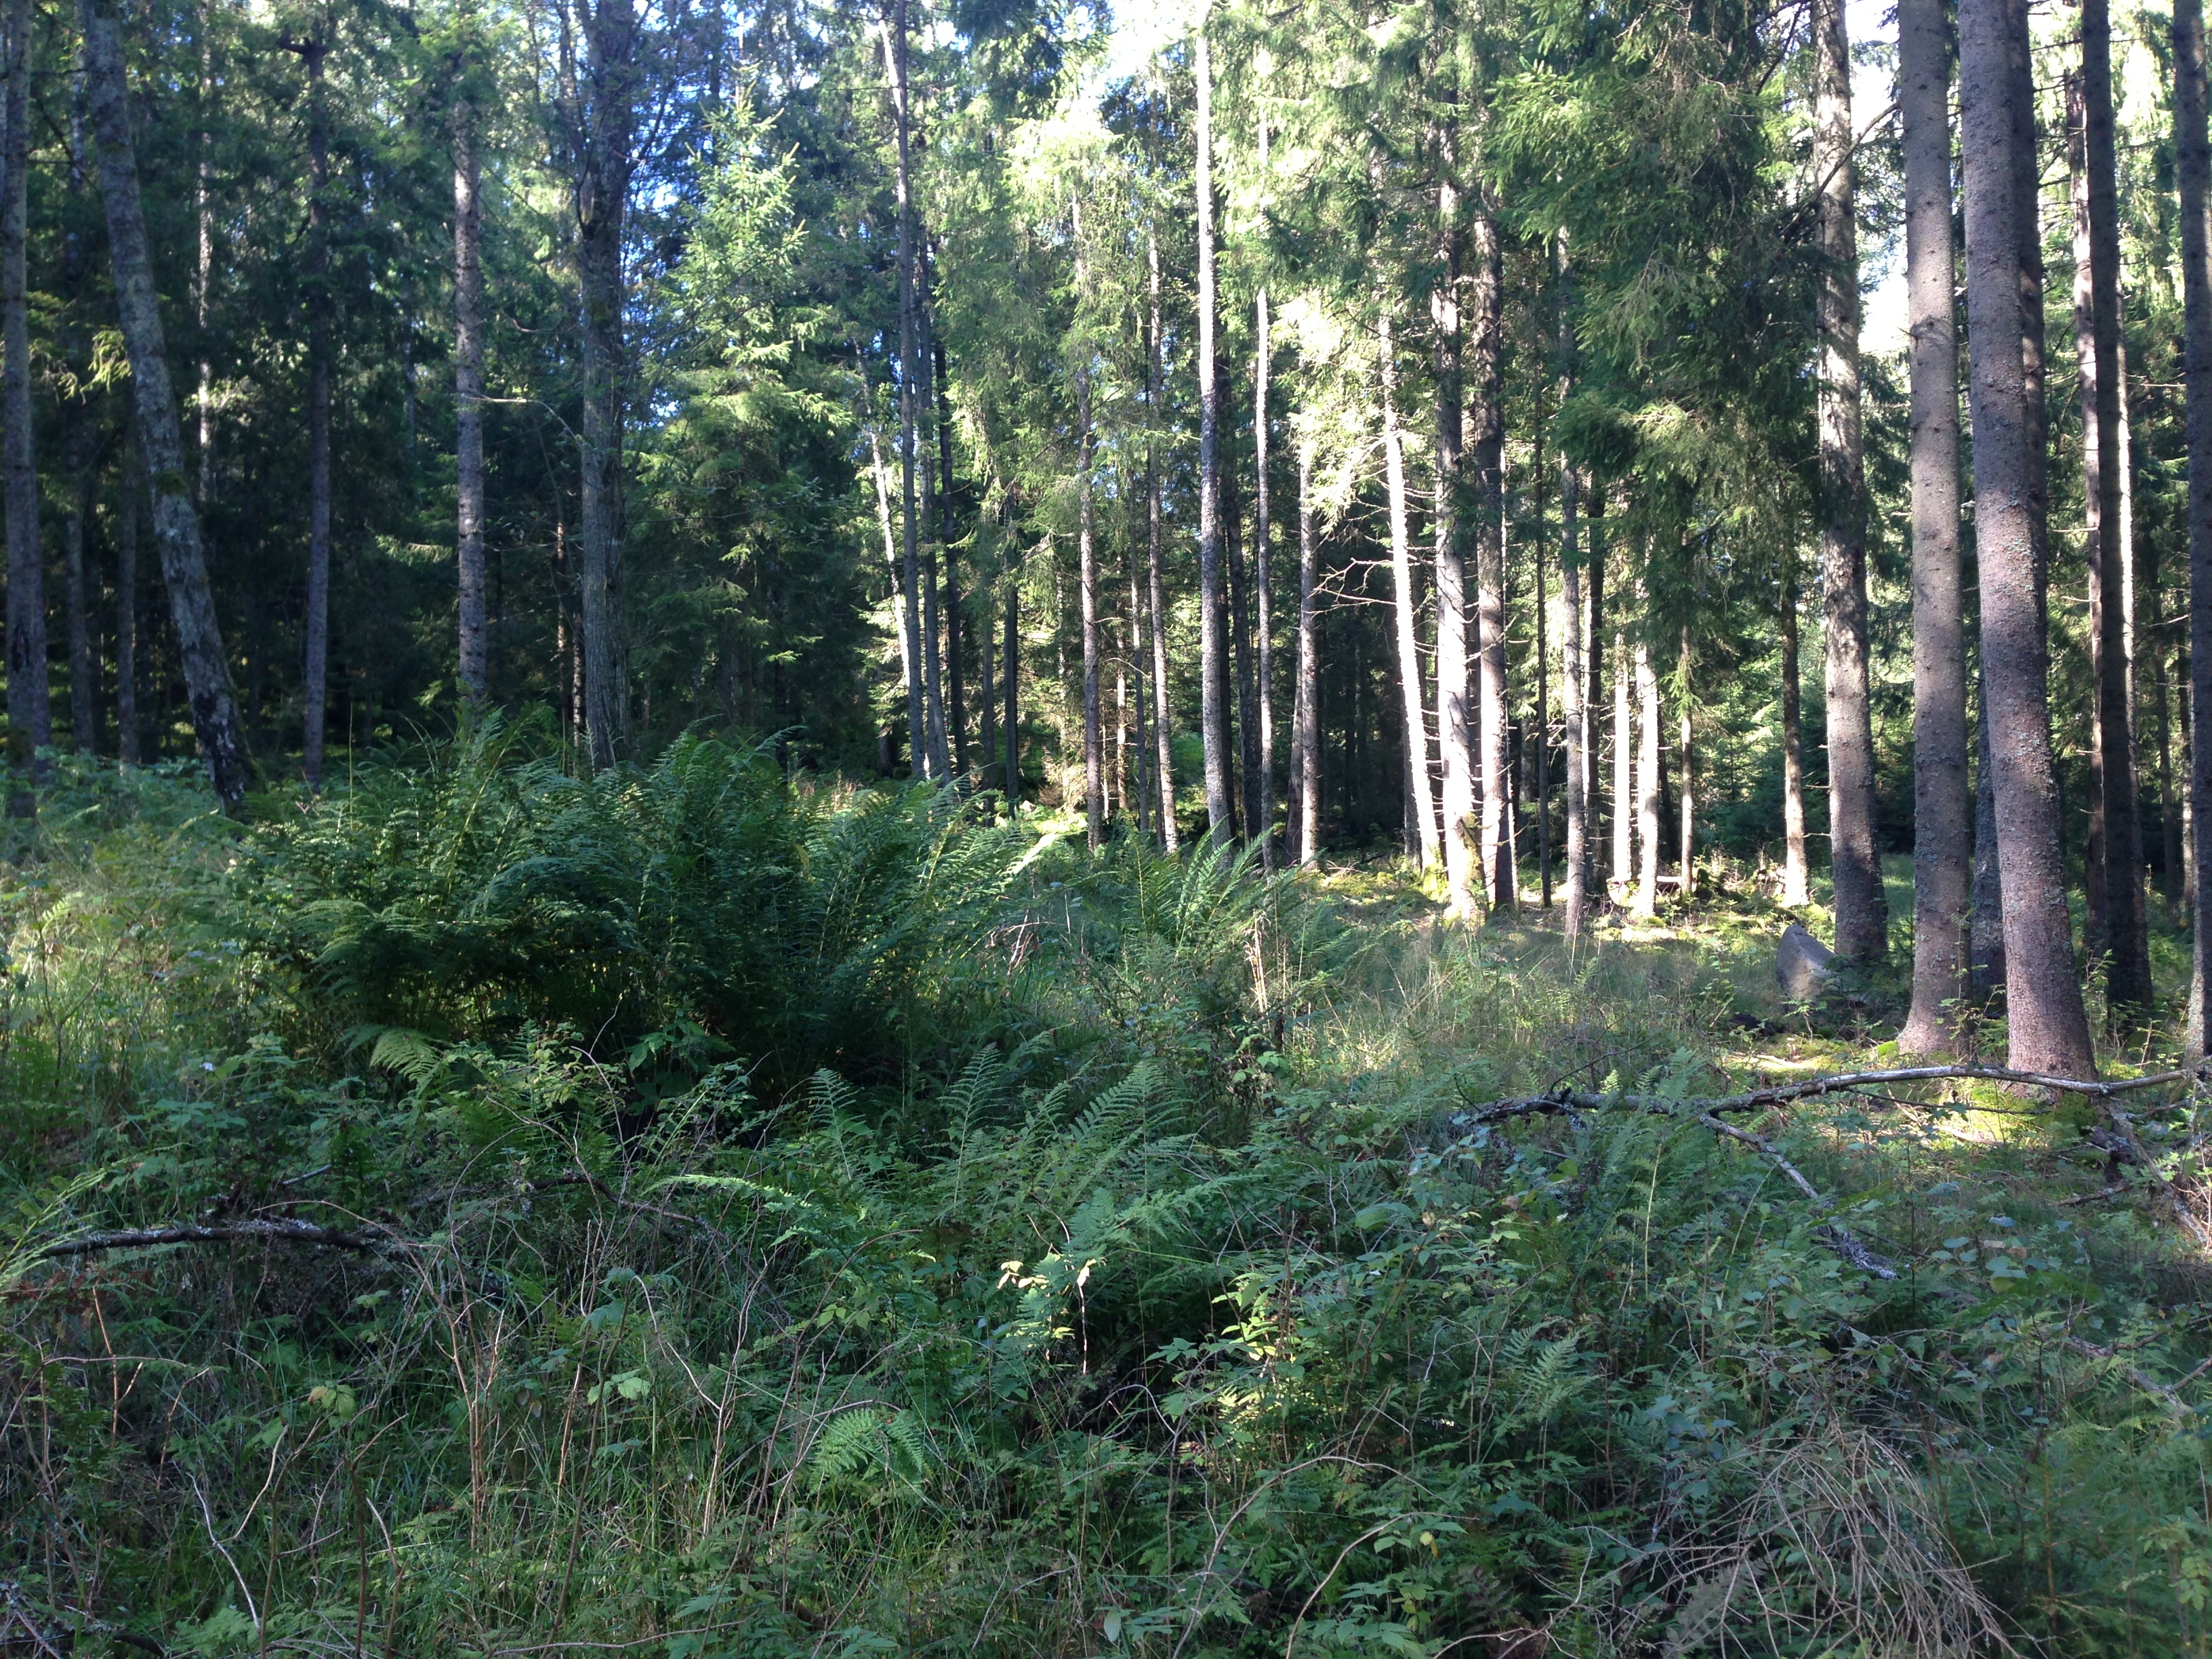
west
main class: Woodland
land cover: Spruce dominated coniferous woodland
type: boreal forest
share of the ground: 50 - 75 %
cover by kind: coniferous forest trees 70 %, shrubs 15 %, herbaceous plants 15 %
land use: Forestry
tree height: > 5 m
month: September
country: SE
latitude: 57.2081
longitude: 13.2575
